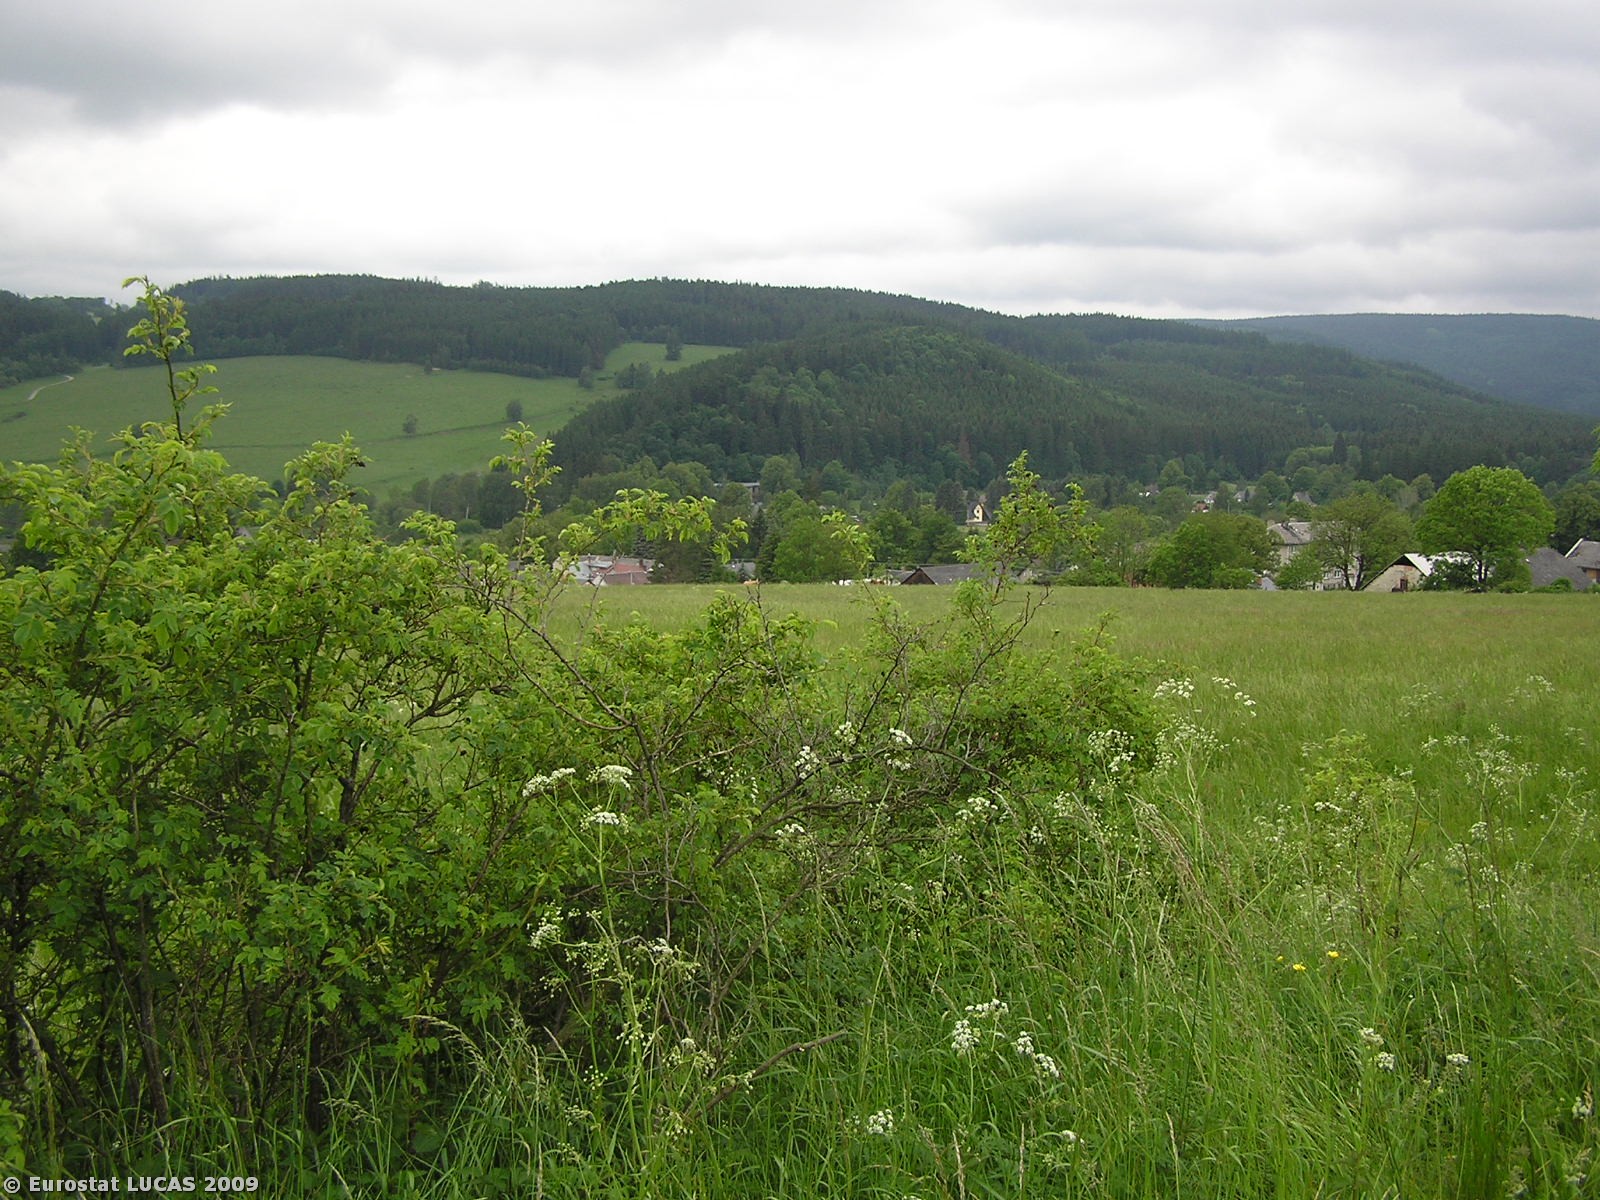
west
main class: Grassland
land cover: Grassland without tree/shrub cover
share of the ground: > 75 %
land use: Agriculture (excluding fallow land and kitchen gardens)
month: June
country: CZ
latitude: 50.0644
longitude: 17.4862
